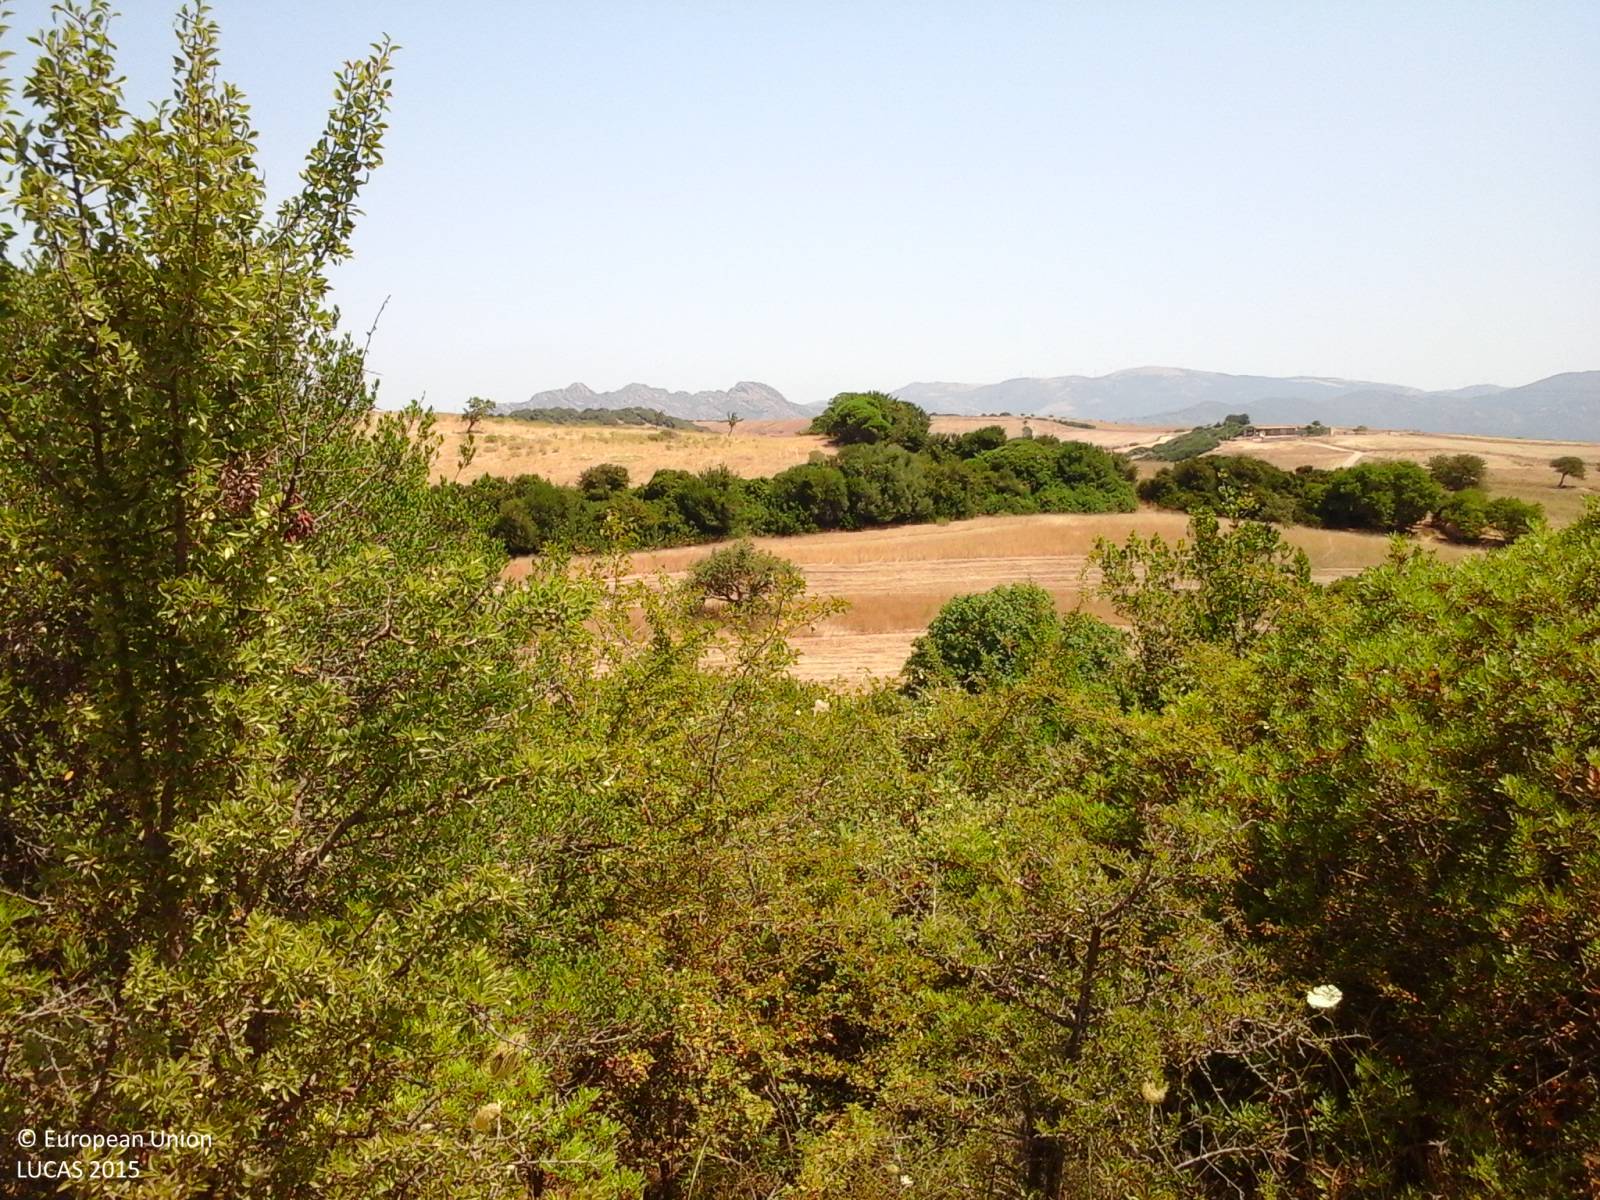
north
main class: Shrubland
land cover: Shrubland with sparse tree cover
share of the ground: > 75 %
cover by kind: herbaceous plants 55 %, shrubs 40 %, broadleaved forest trees 5 %
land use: Semi-natural and natural areas not in use
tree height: < 5 m
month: July
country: IT
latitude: 40.8401
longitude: 8.8786
